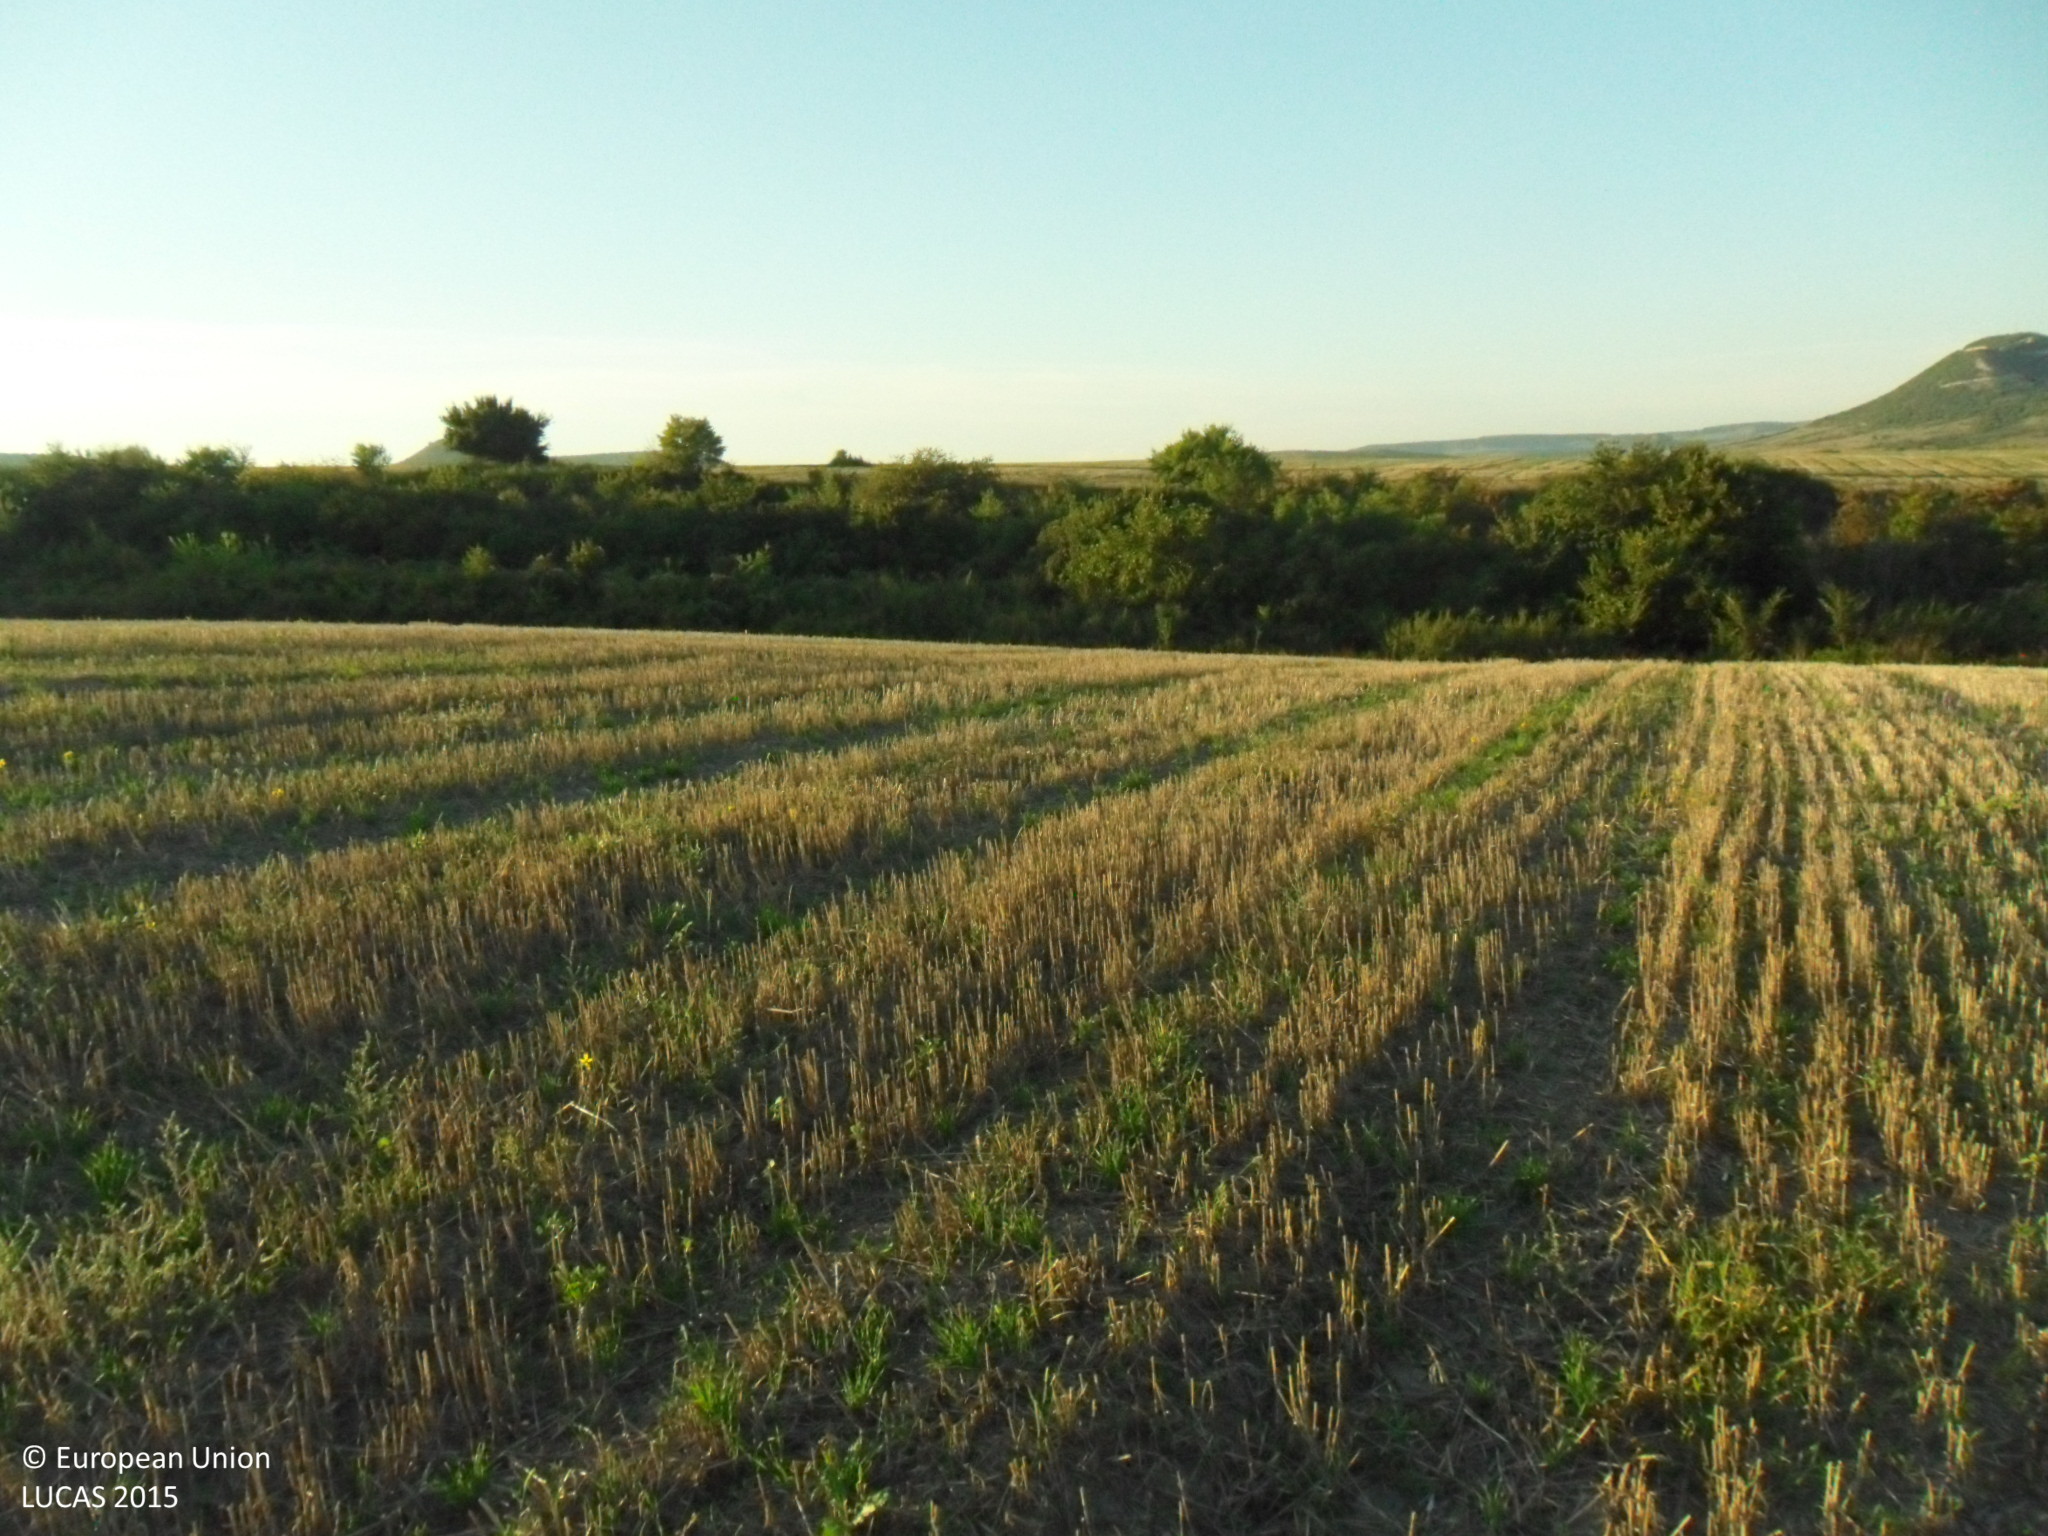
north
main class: Cropland
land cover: Common wheat
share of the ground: > 75 %
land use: Agriculture (excluding fallow land and kitchen gardens)
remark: Harvested field
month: September
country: BG
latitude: 43.4245
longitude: 27.1541
